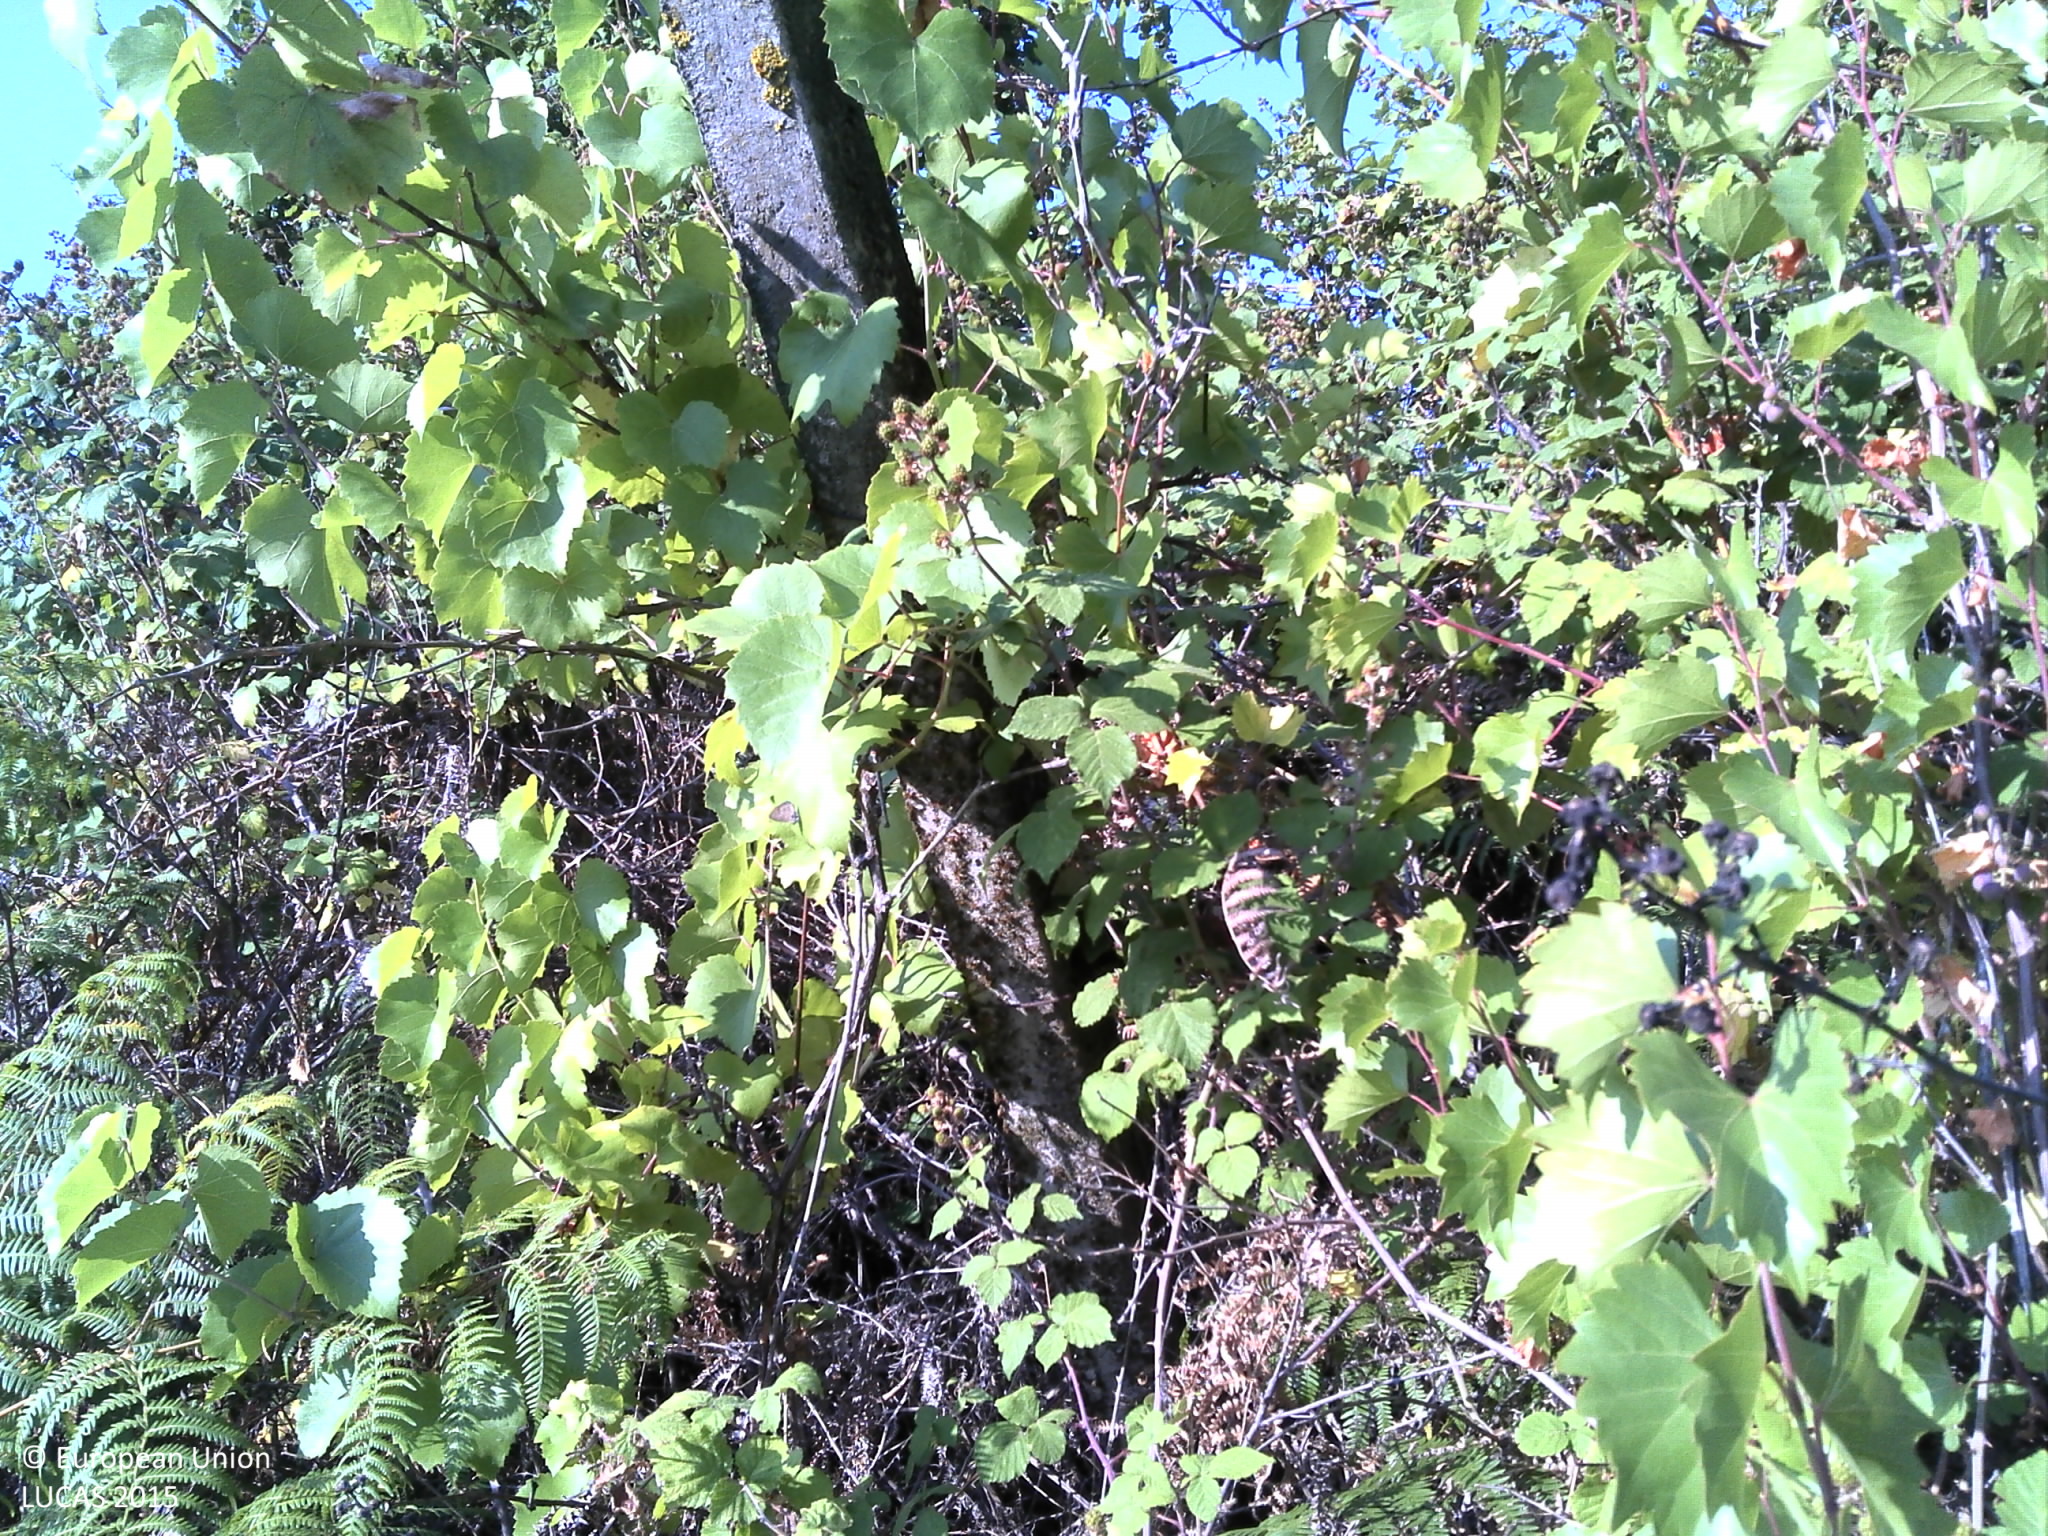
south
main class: Shrubland
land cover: Shrubland with sparse tree cover
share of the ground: > 75 %
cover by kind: shrubs 90 %, coniferous forest trees 5 %, herbaceous plants 5 %
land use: Abandoned areas
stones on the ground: 25 - 50 %
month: July
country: PT
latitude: 41.4049
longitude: -7.4330
